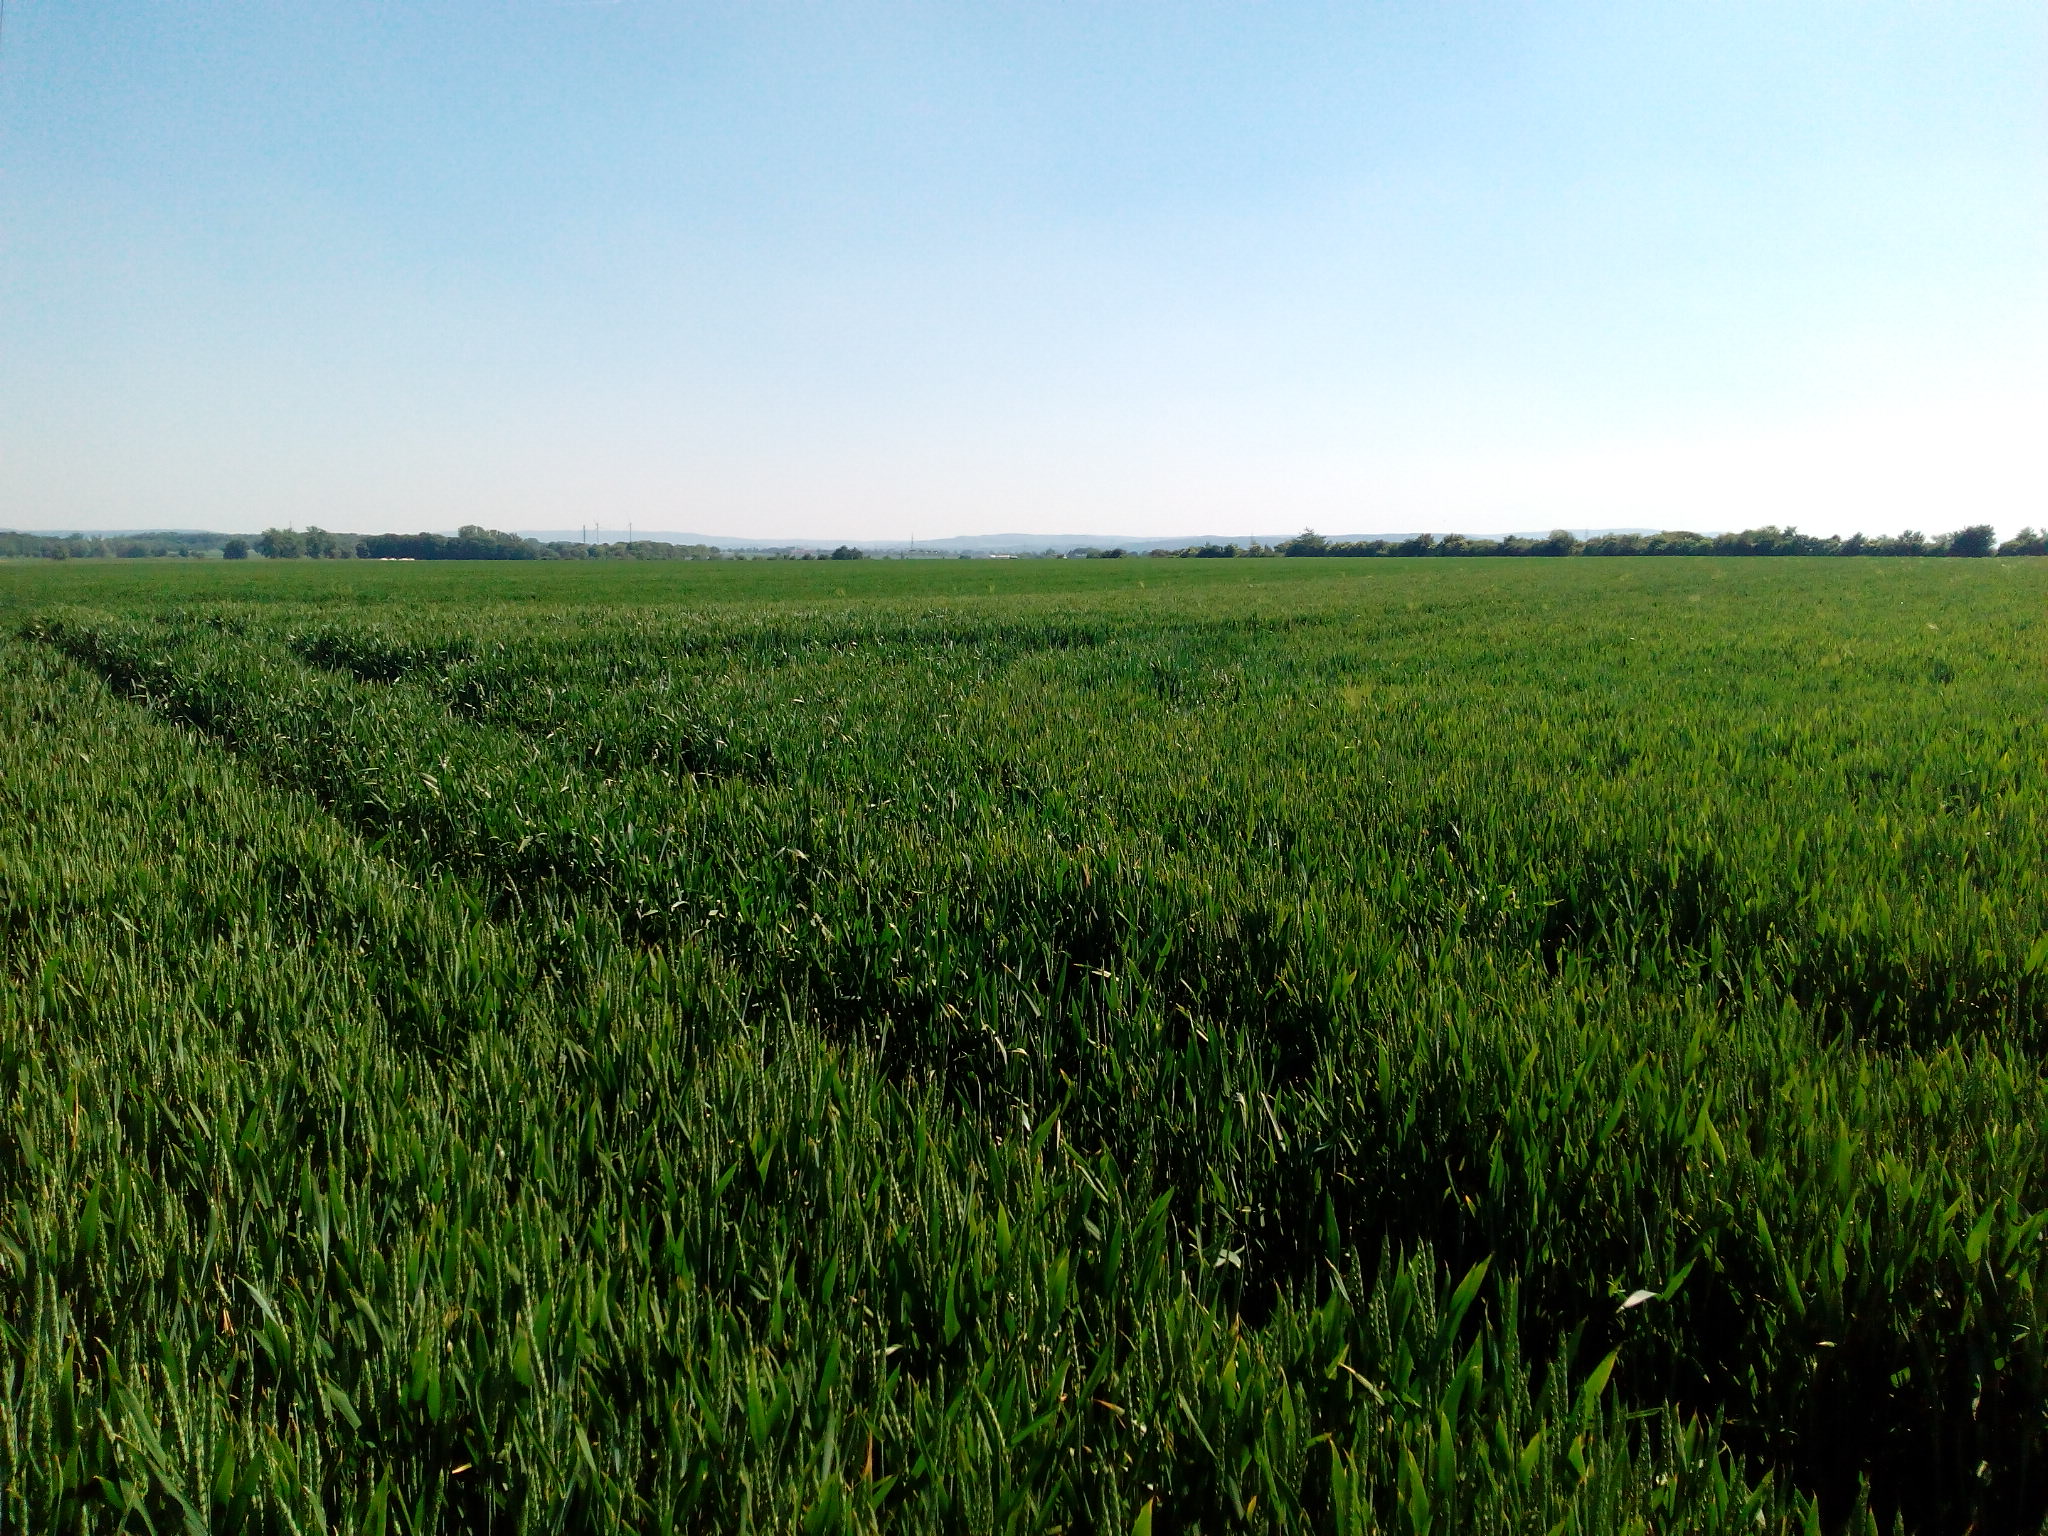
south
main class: Cropland
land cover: Common wheat
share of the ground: > 75 %
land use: Agriculture (excluding fallow land and kitchen gardens)
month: June
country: DE
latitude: 52.2516
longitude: 9.9268
